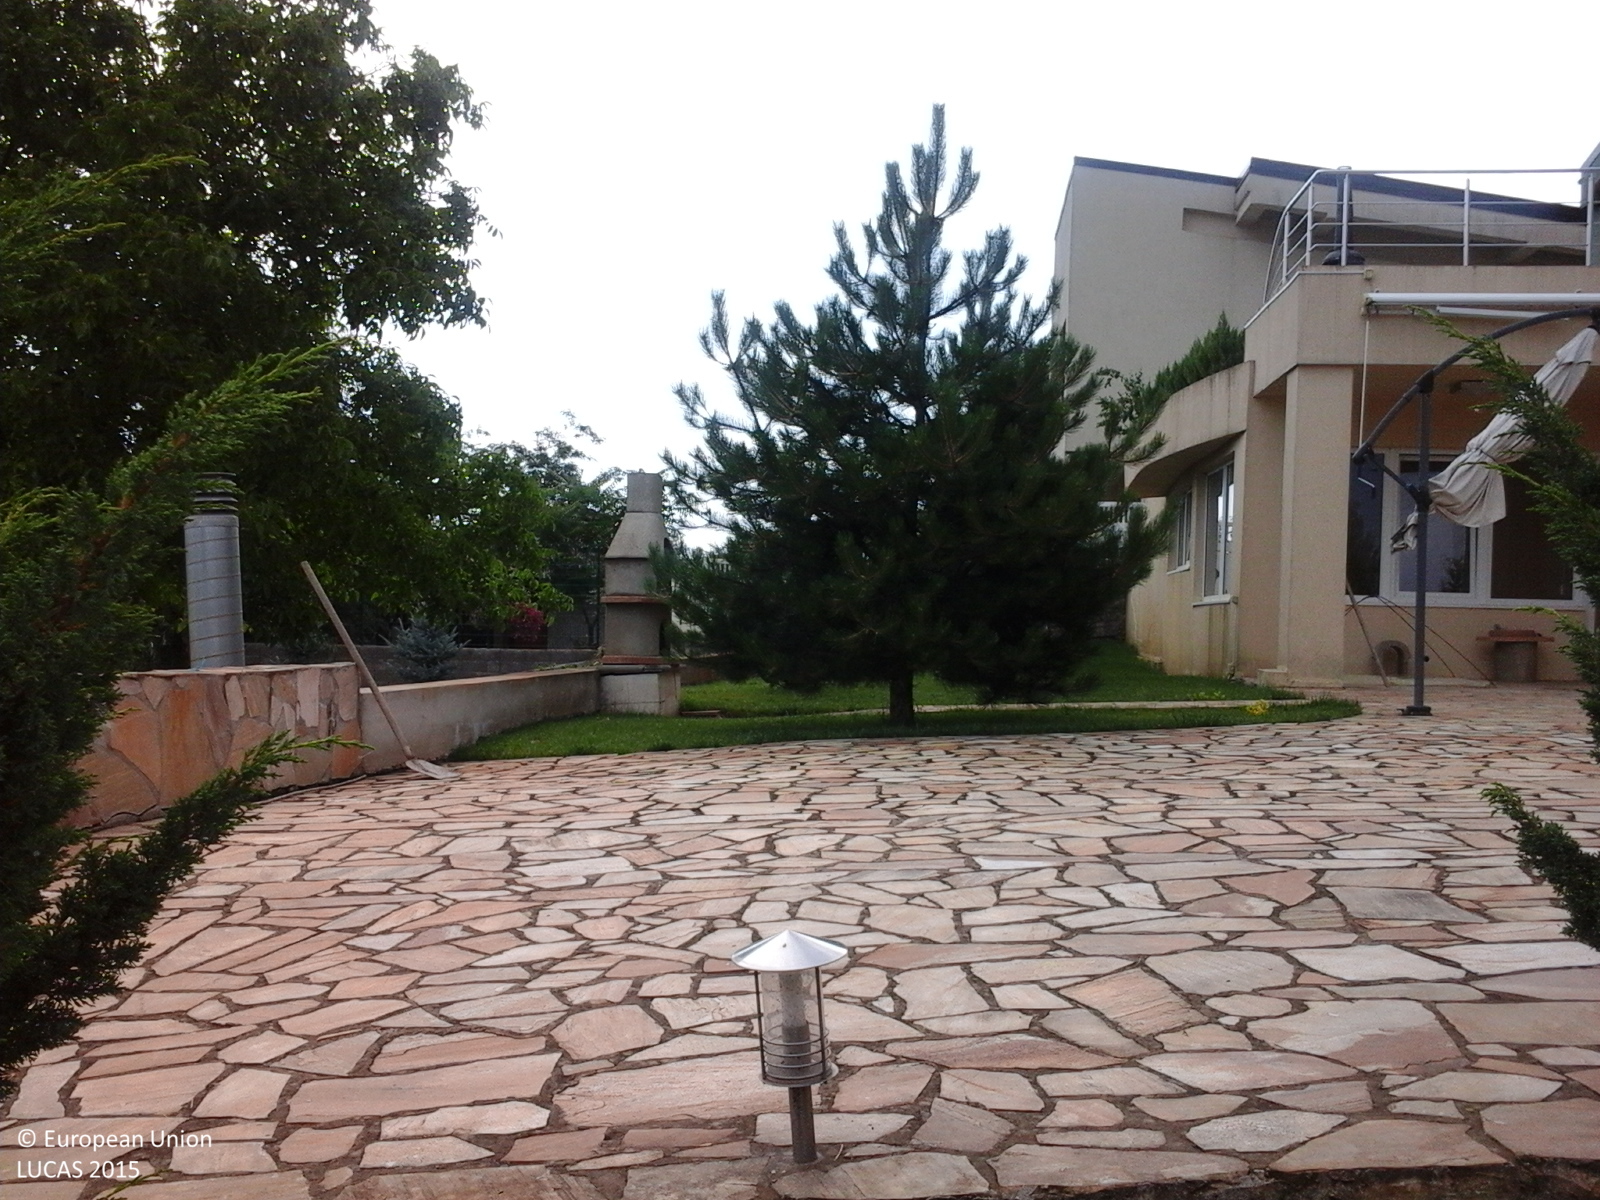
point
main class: Grassland
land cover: Grassland with sparse tree/shrub cover
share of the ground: > 75 %
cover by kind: herbaceous plants 95 %, coniferous forest trees 5 %
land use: Residential
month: June
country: RO
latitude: 44.6020
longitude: 26.0172
